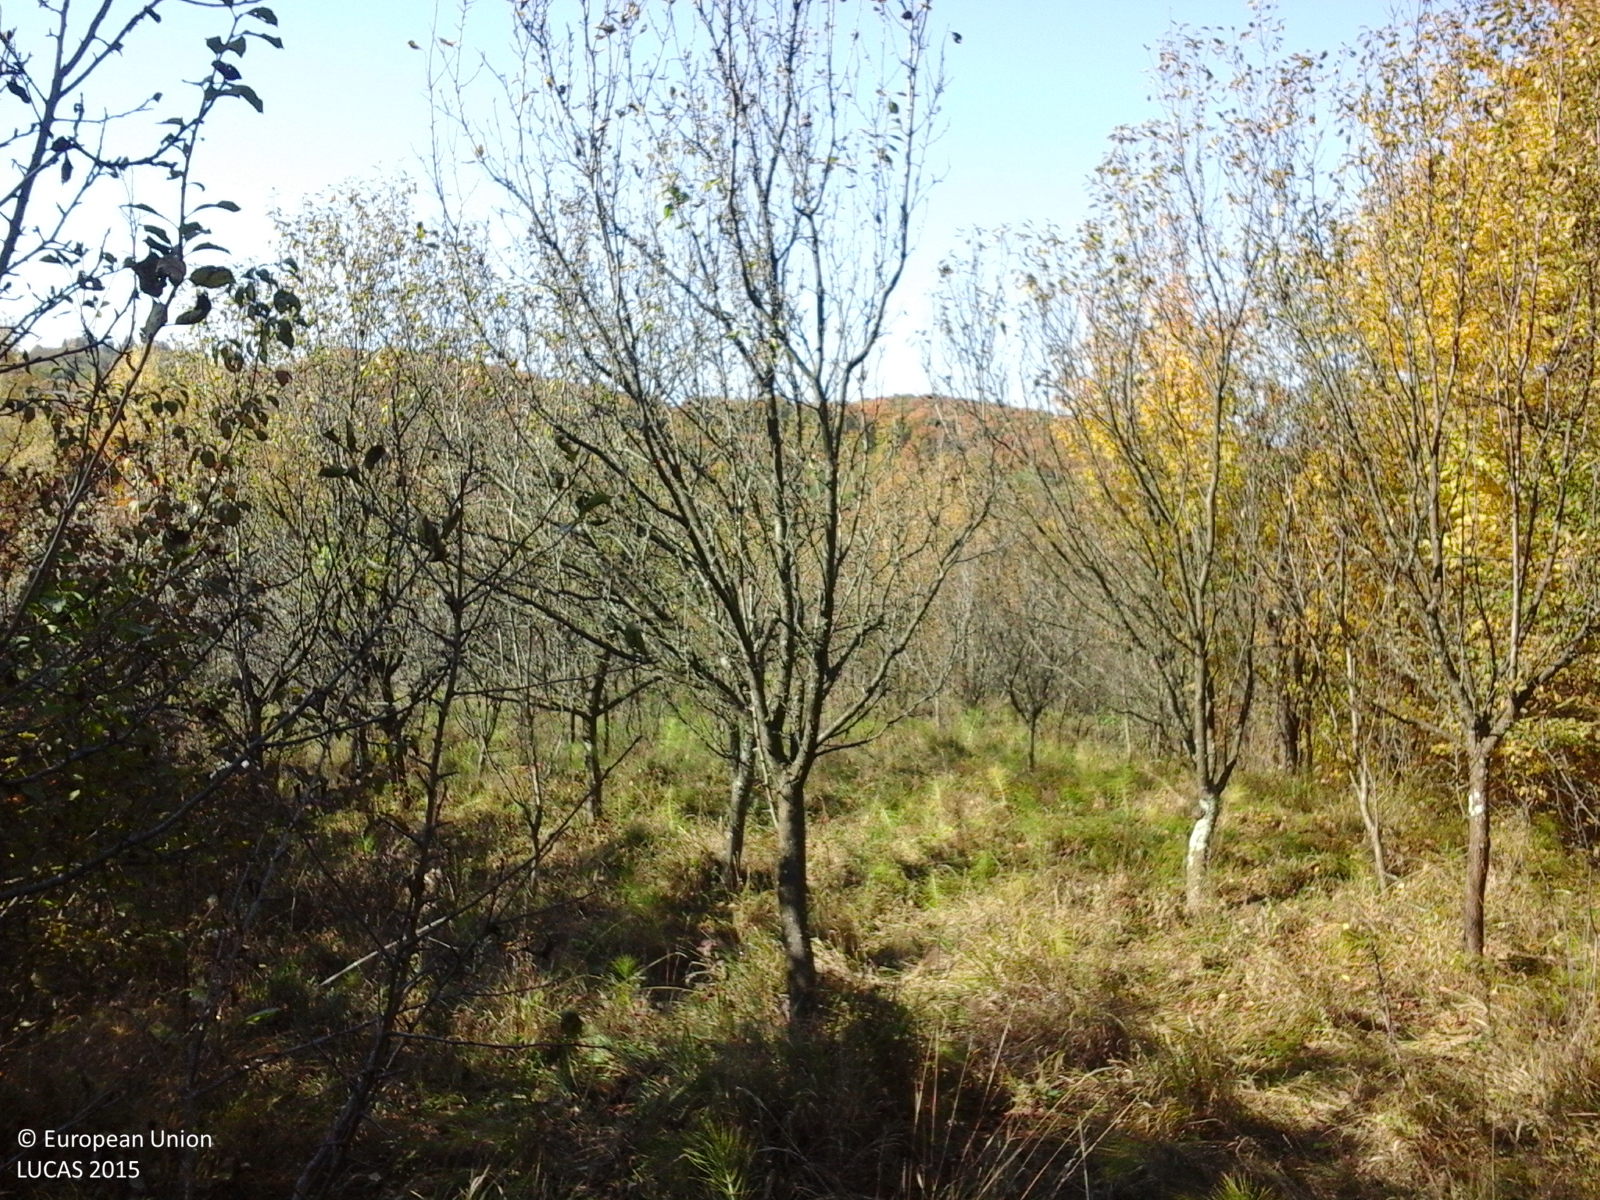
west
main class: Grassland
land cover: Grassland with sparse tree/shrub cover
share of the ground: > 75 %
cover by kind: herbaceous plants 85 %, shrubs 10 %, broadleaved forest trees 5 %
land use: Fallow land
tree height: < 5 m
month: October
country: RO
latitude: 45.1069
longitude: 26.4262
